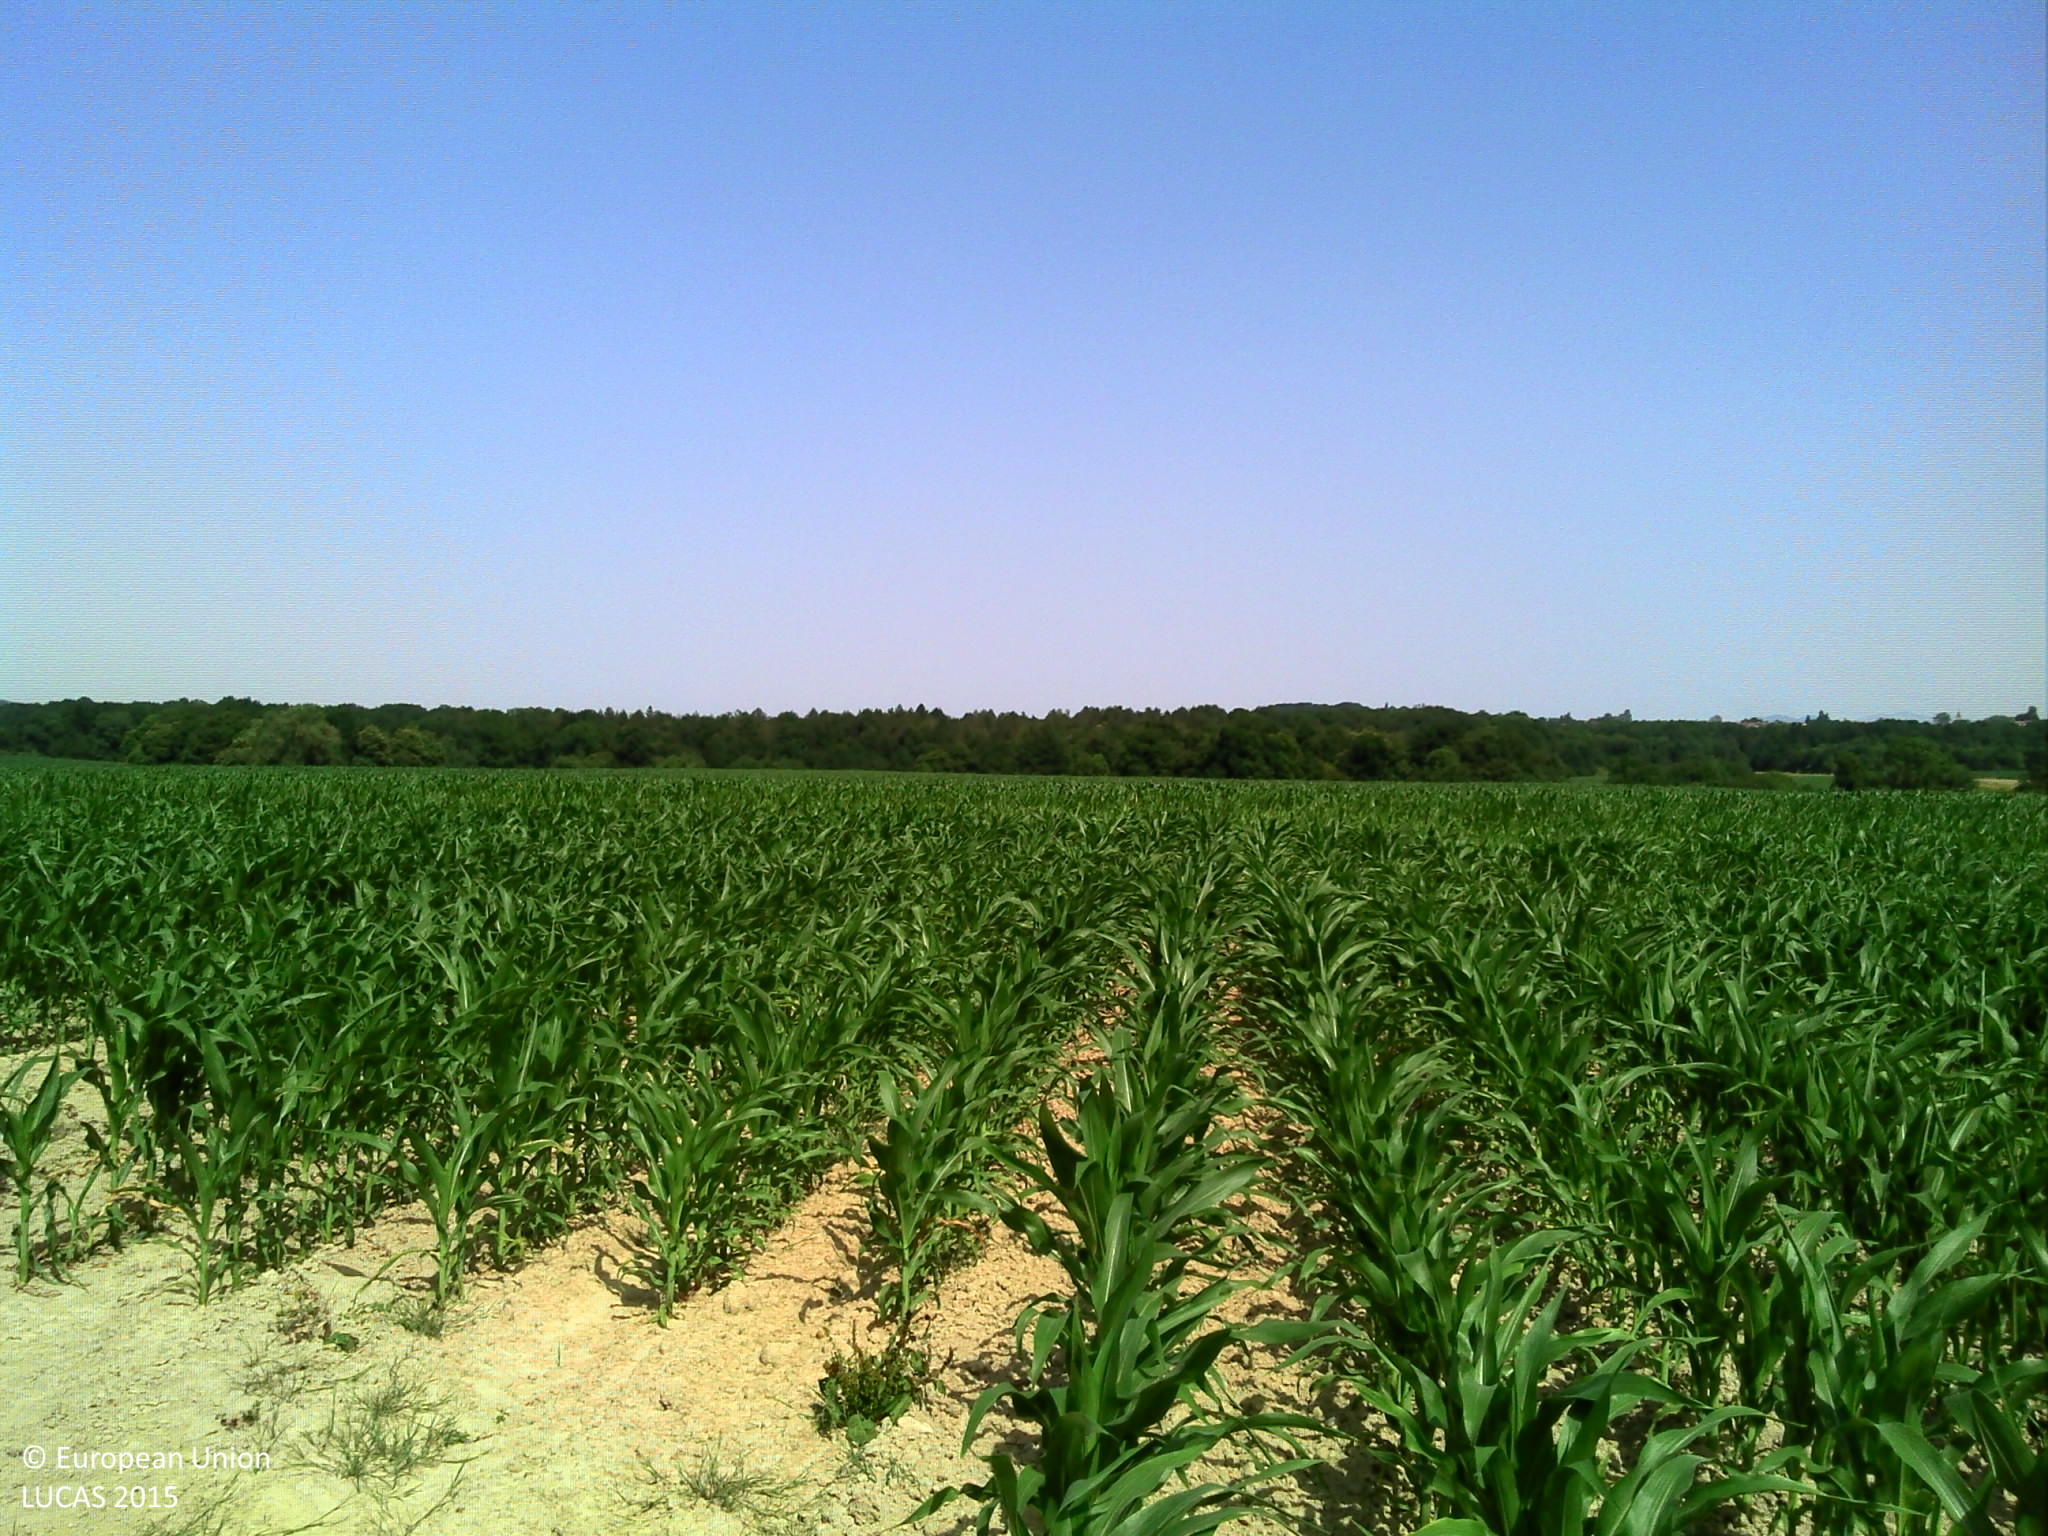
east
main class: Cropland
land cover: Maize
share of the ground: 50 - 75 %
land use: Agriculture (excluding fallow land and kitchen gardens)
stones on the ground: < 10 %
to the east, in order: Maize; Grass margins; Maize; Grass margins; Tracks; Grass margins; Maize
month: July
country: FR
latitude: 43.0948
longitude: 0.8745
